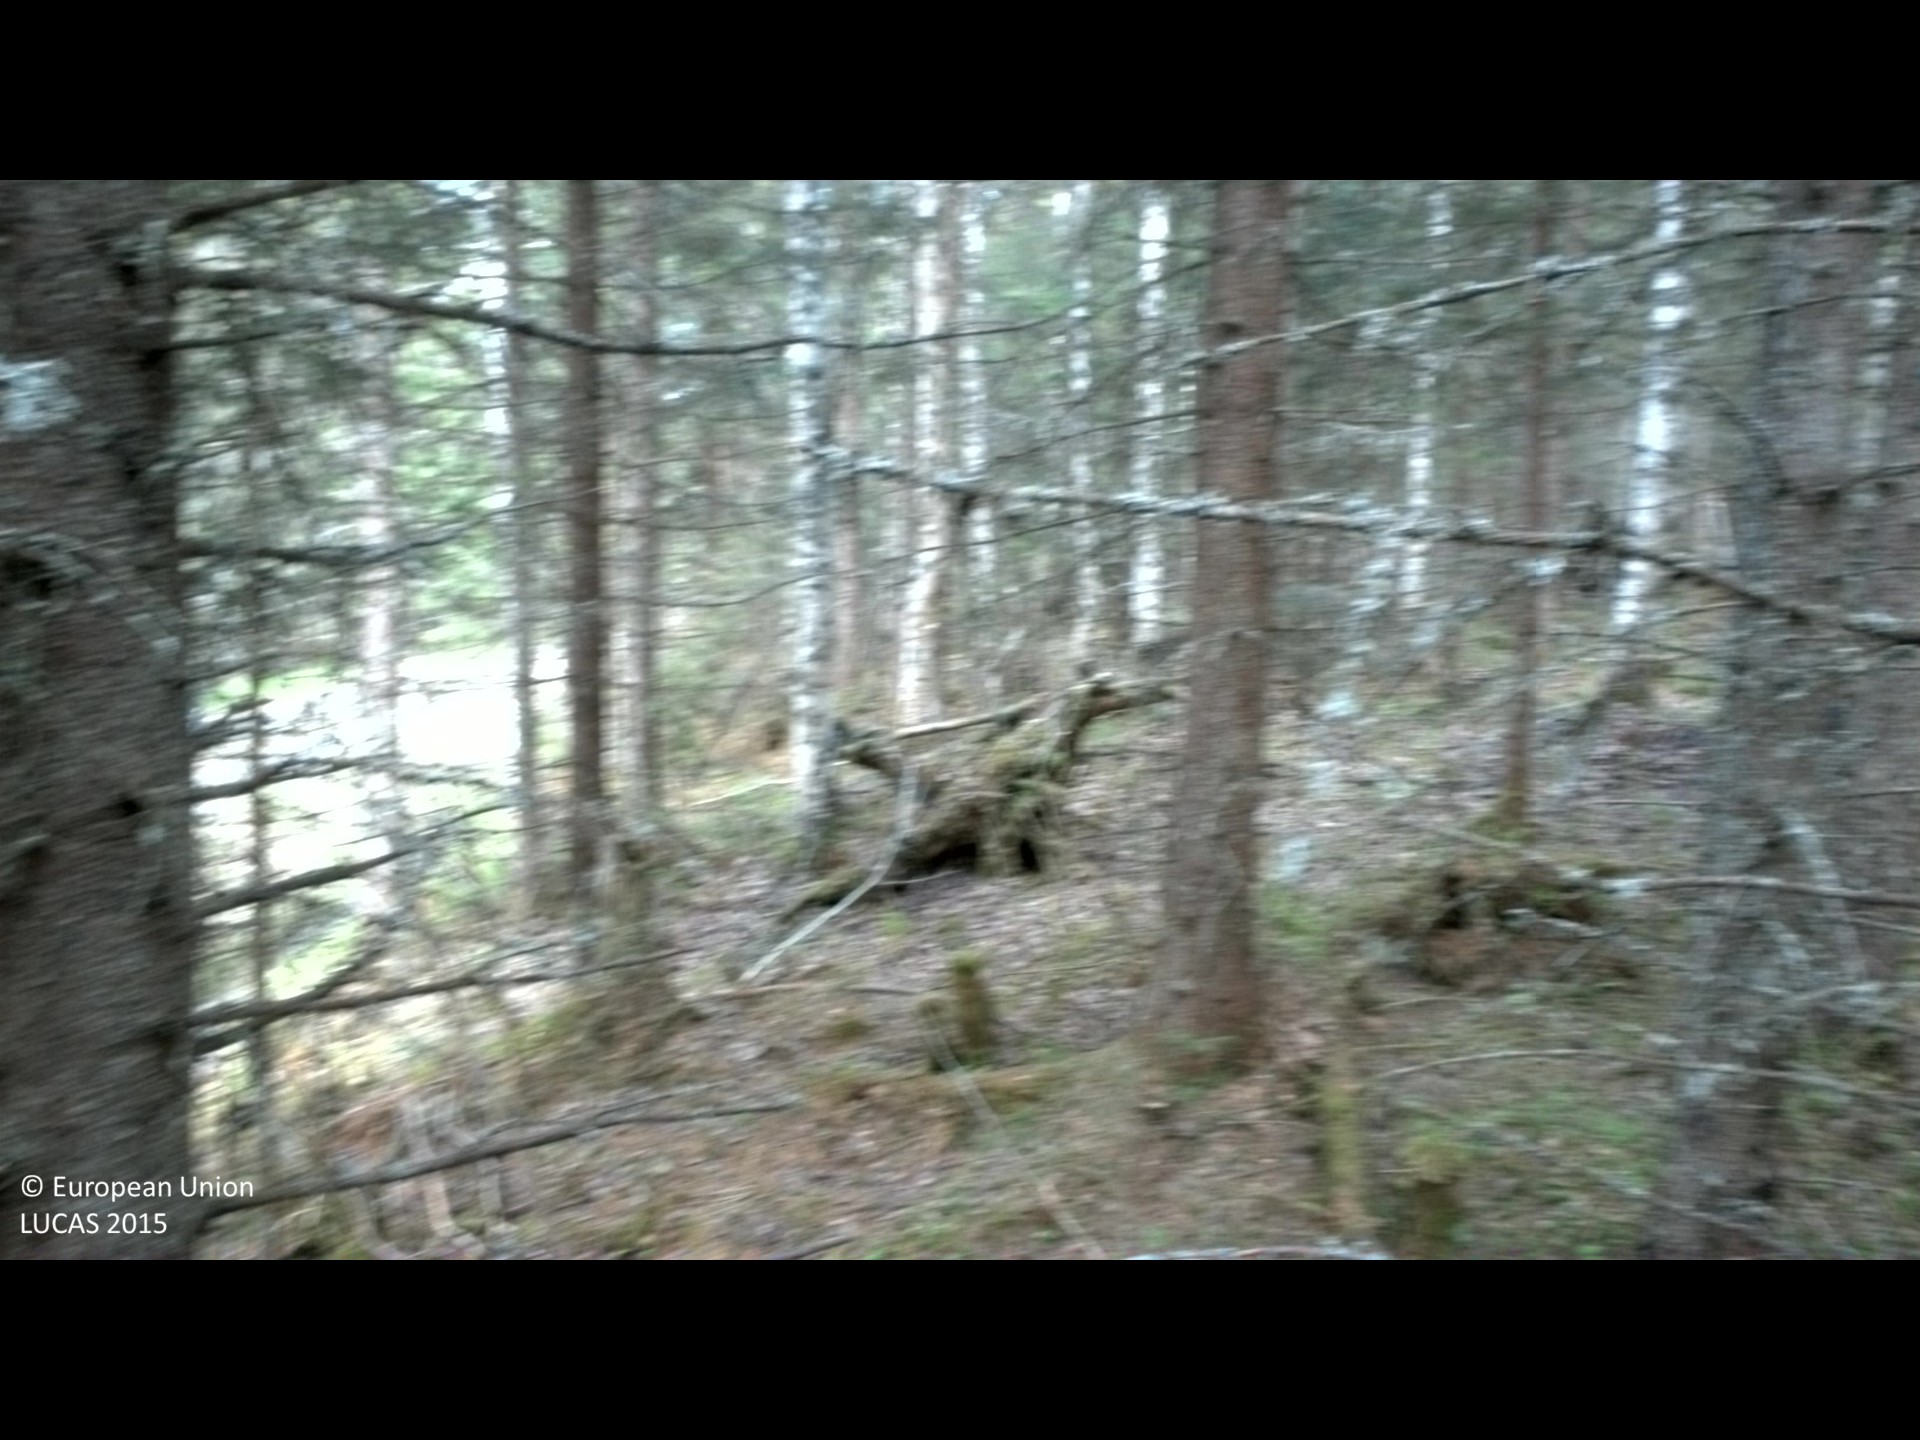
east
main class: Woodland
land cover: Spruce dominated mixed woodland
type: boreal forest
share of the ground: 50 - 75 %
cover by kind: coniferous forest trees 40 %, broadleaved forest trees 20 %
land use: Forestry
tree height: > 5 m
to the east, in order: Spruce dominated mixed woodland; Spruce dominated coniferous woodland
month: May
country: SE
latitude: 63.0328
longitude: 17.3098
